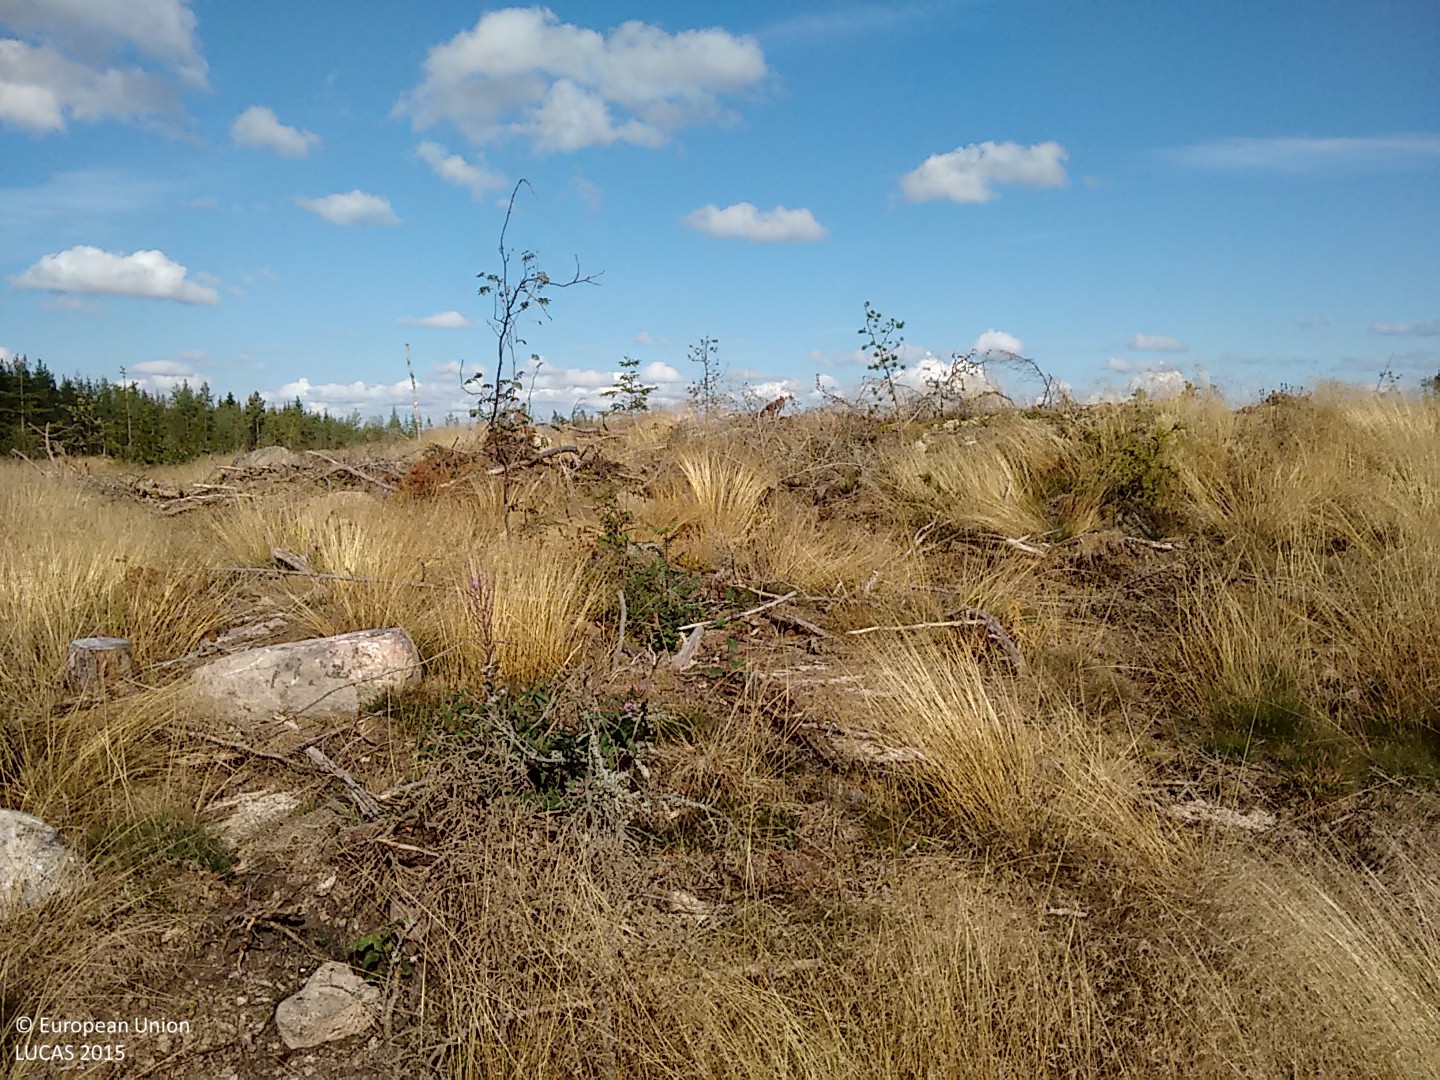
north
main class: Grassland
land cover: Grassland with sparse tree/shrub cover
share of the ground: > 75 %
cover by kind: herbaceous plants 80 %, consolidated bare surface 10 %, broadleaved forest trees 5 %, unconsolidated bare surface 5 %
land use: Forestry
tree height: < 5 m
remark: Clear cut
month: September
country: FI
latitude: 60.9348
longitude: 21.6630
